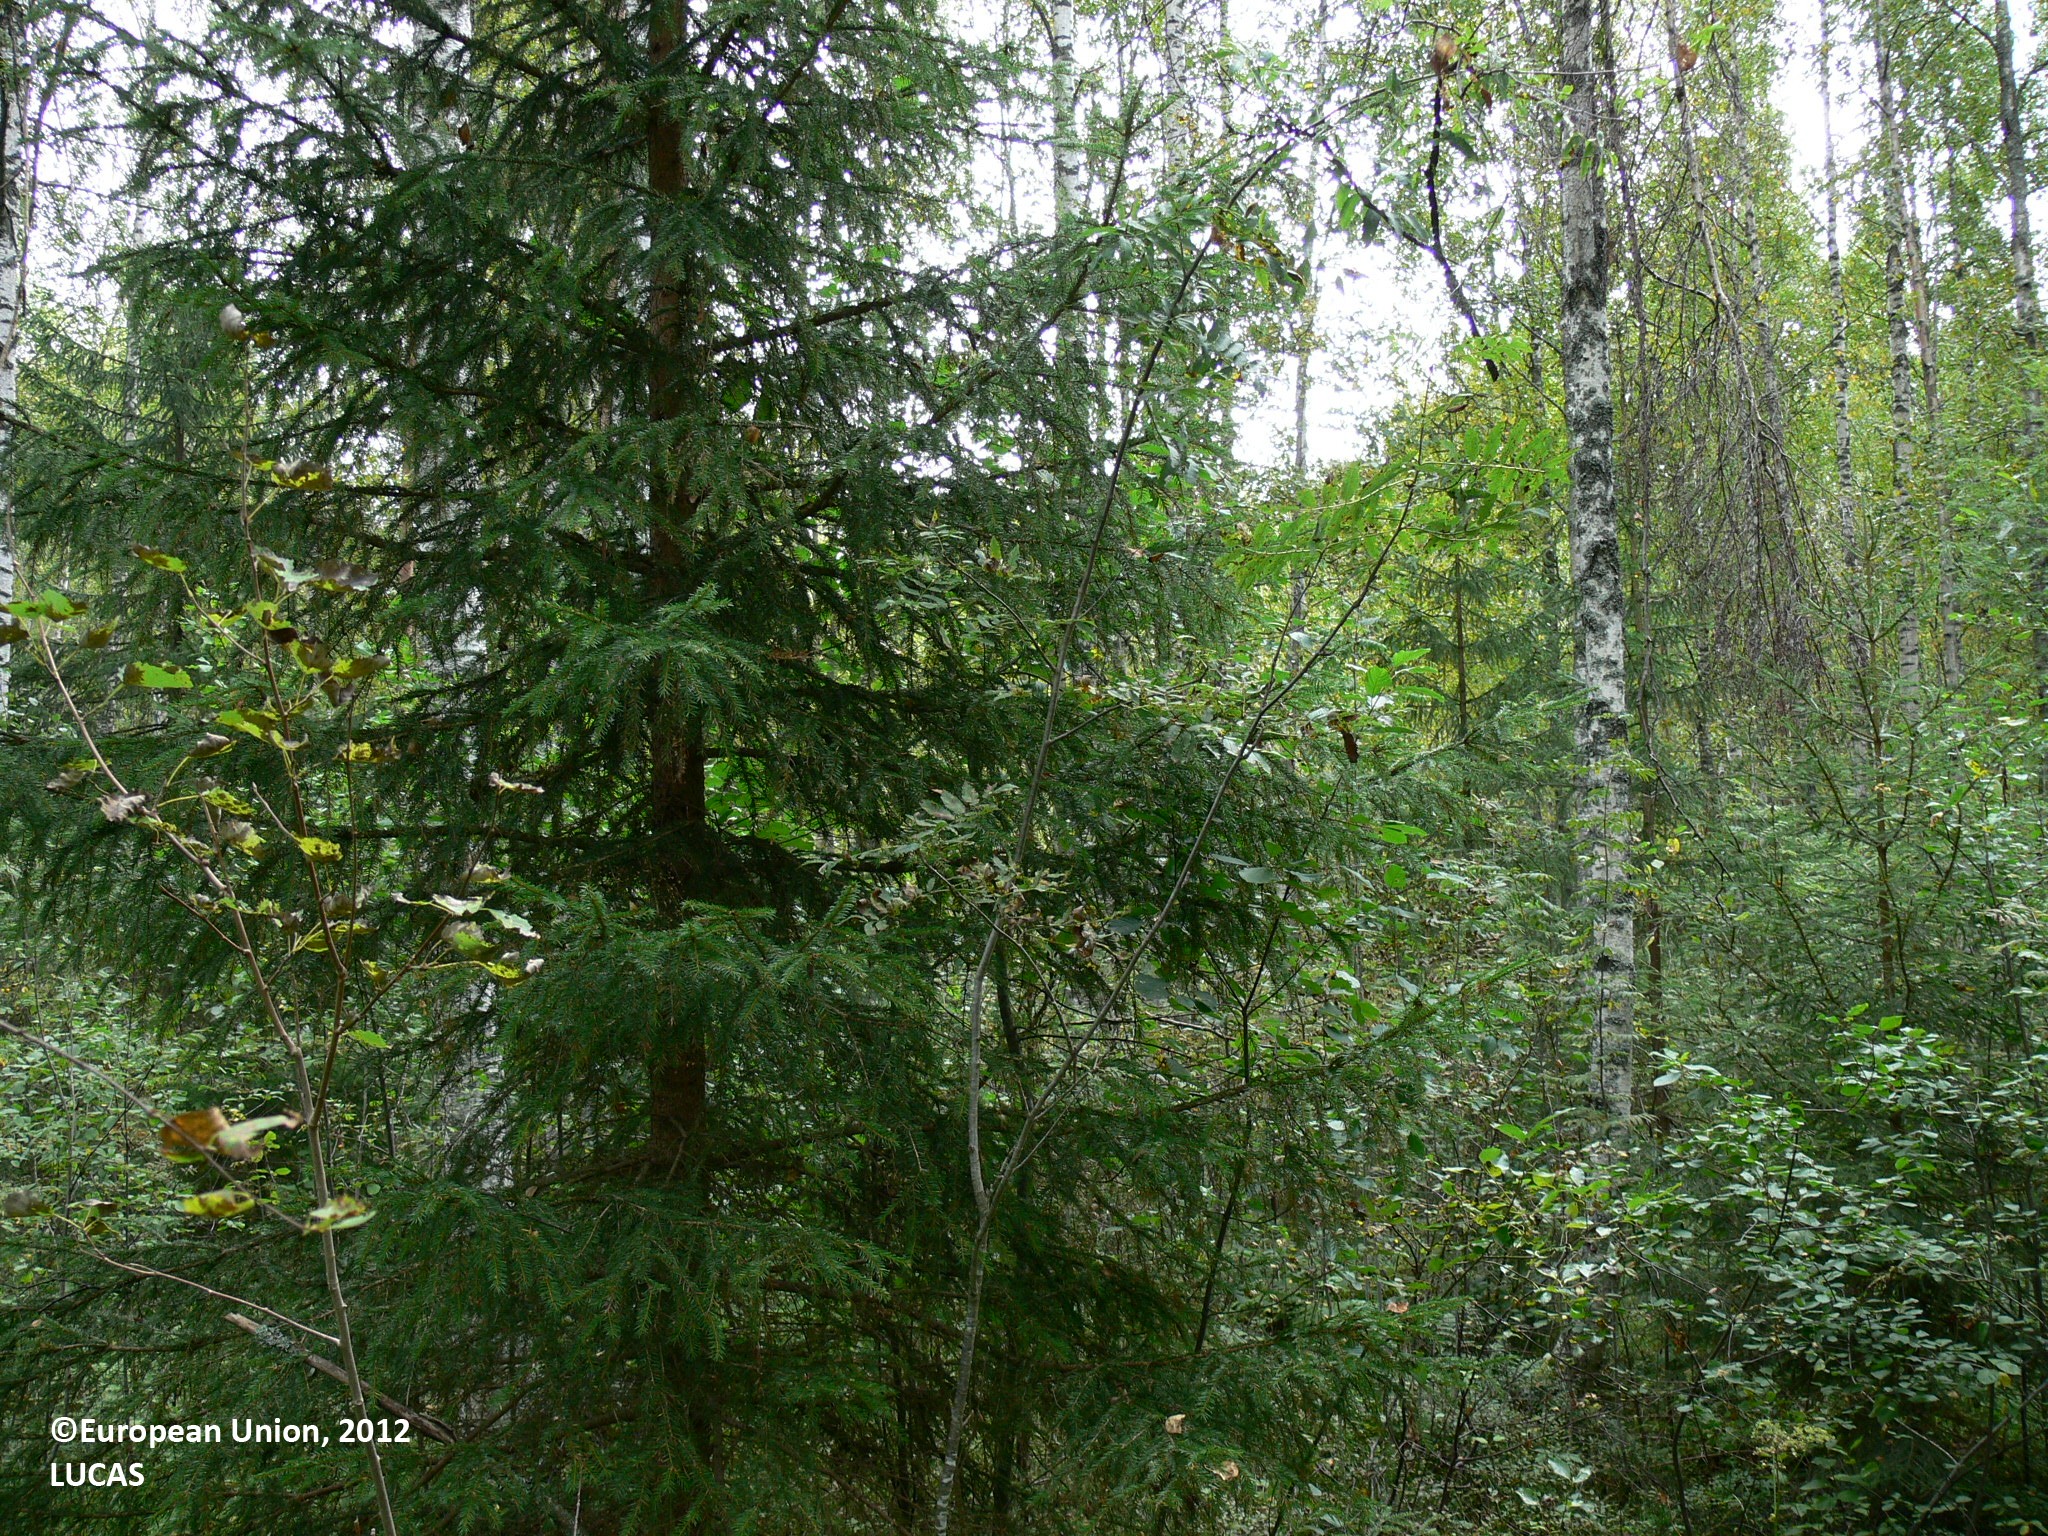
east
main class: Woodland
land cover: Other mixed woodland
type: boreal forest
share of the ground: > 75 %
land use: Forestry
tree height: > 5 m
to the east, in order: Other mixed woodland; Spruce dominated mixed woodland; Grass margins; Tracks; Grass margins; Spruce dominated mixed woodland; Other mixed woodland; Grass margins; Tracks; Grass margins; Artificial constructions in urban areas; Spruce dominated mixed woodland
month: August
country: FI
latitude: 62.0228
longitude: 30.2046
